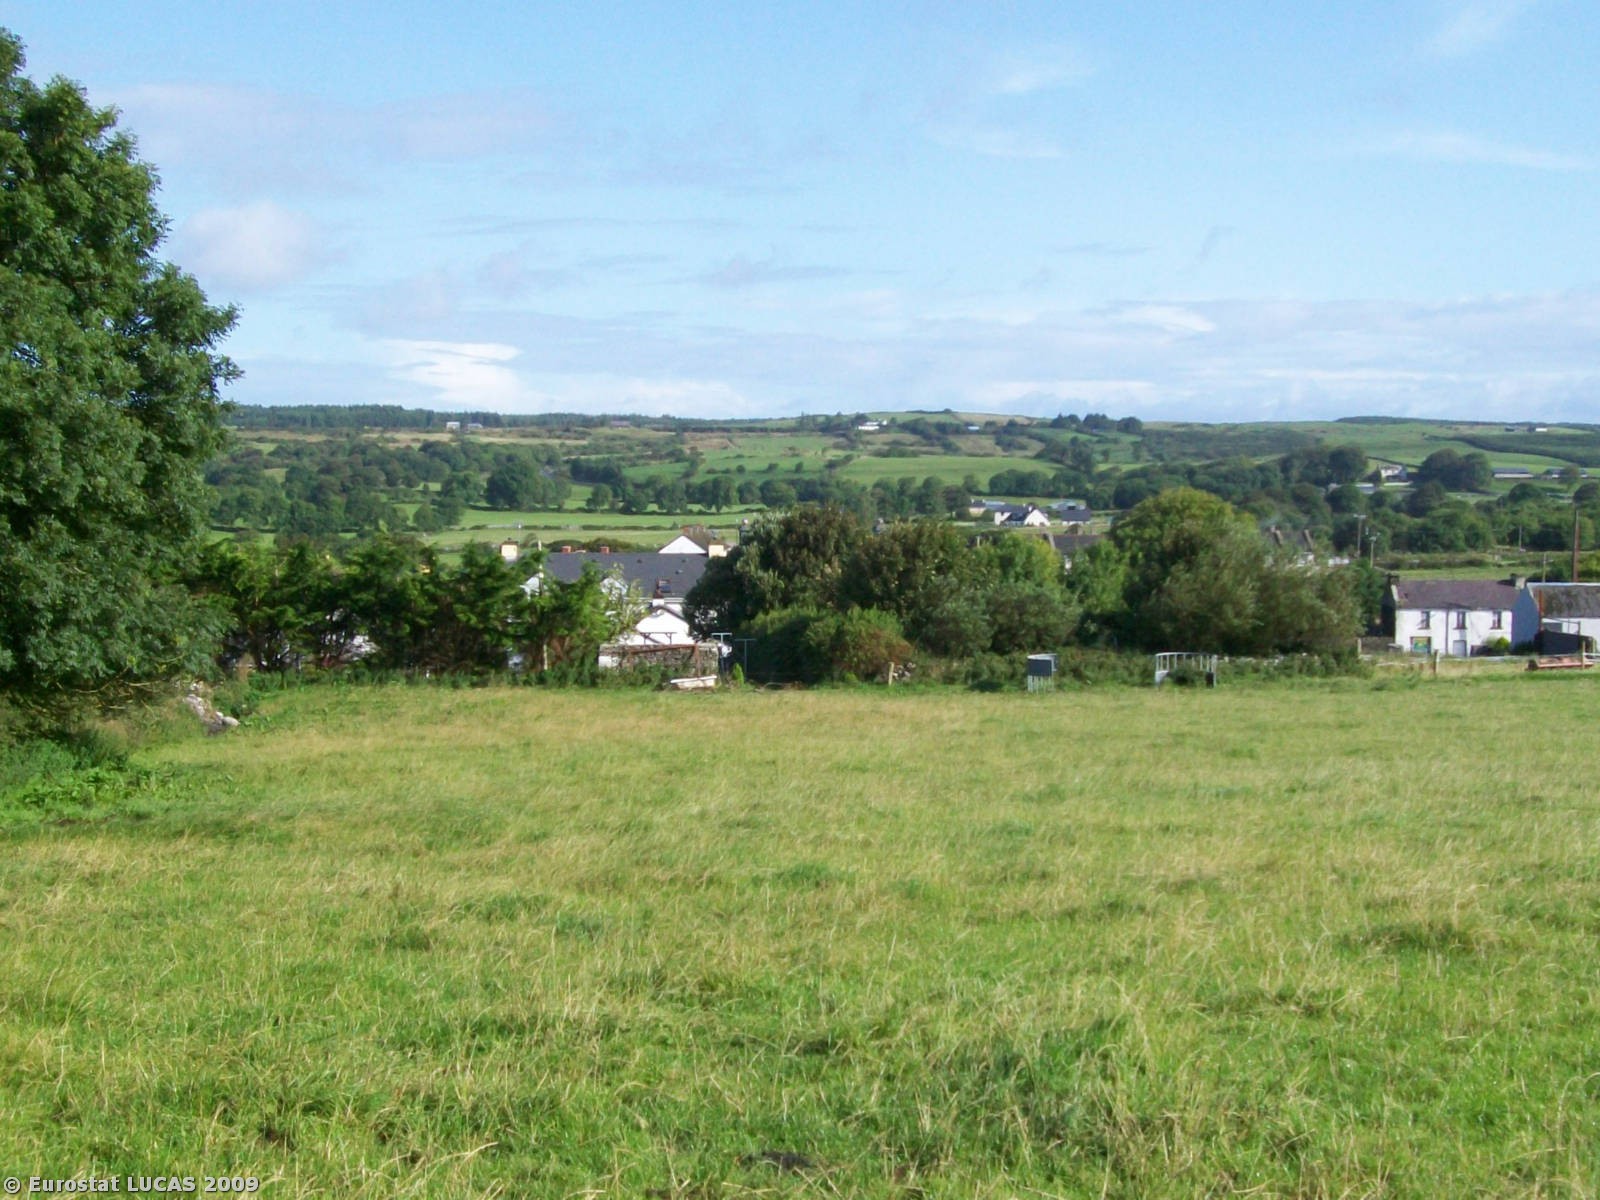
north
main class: Grassland
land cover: Grassland without tree/shrub cover
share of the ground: > 75 %
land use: Agriculture (excluding fallow land and kitchen gardens)
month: August
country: IE
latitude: 52.9890
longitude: -9.2148
